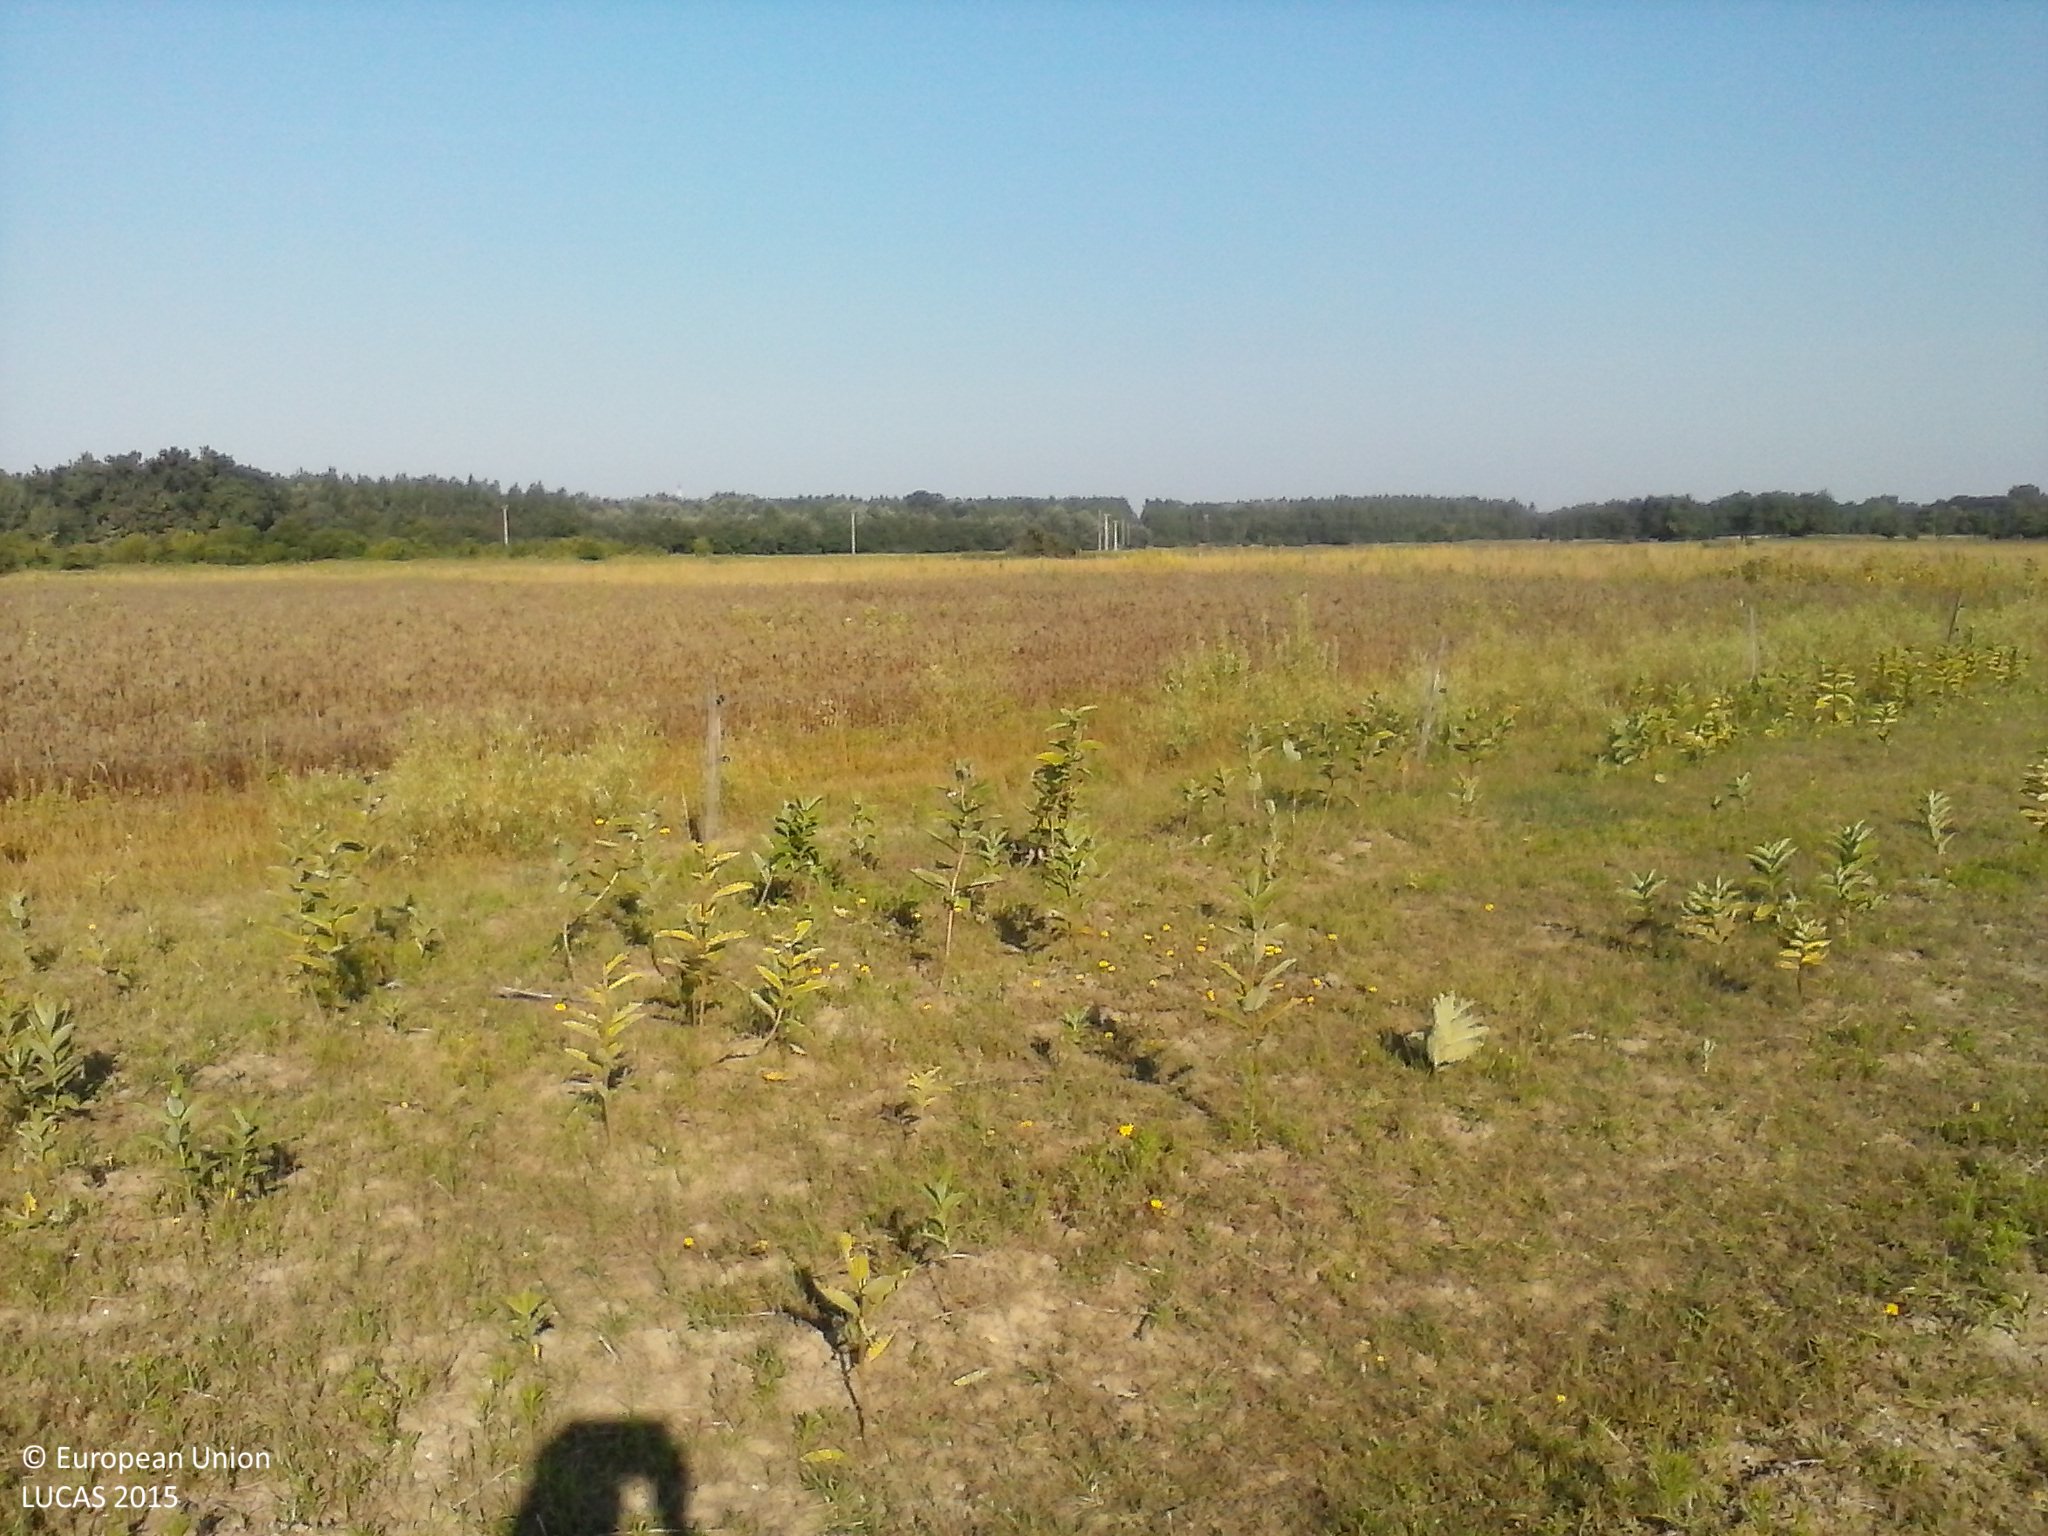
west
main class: Grassland
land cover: Spontaneously vegetated surfaces
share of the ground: > 75 %
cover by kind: herbaceous plants 90 %, unconsolidated bare surface 10 %
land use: Agriculture (excluding fallow land and kitchen gardens)
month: July
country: HU
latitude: 46.3339
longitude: 19.6179
